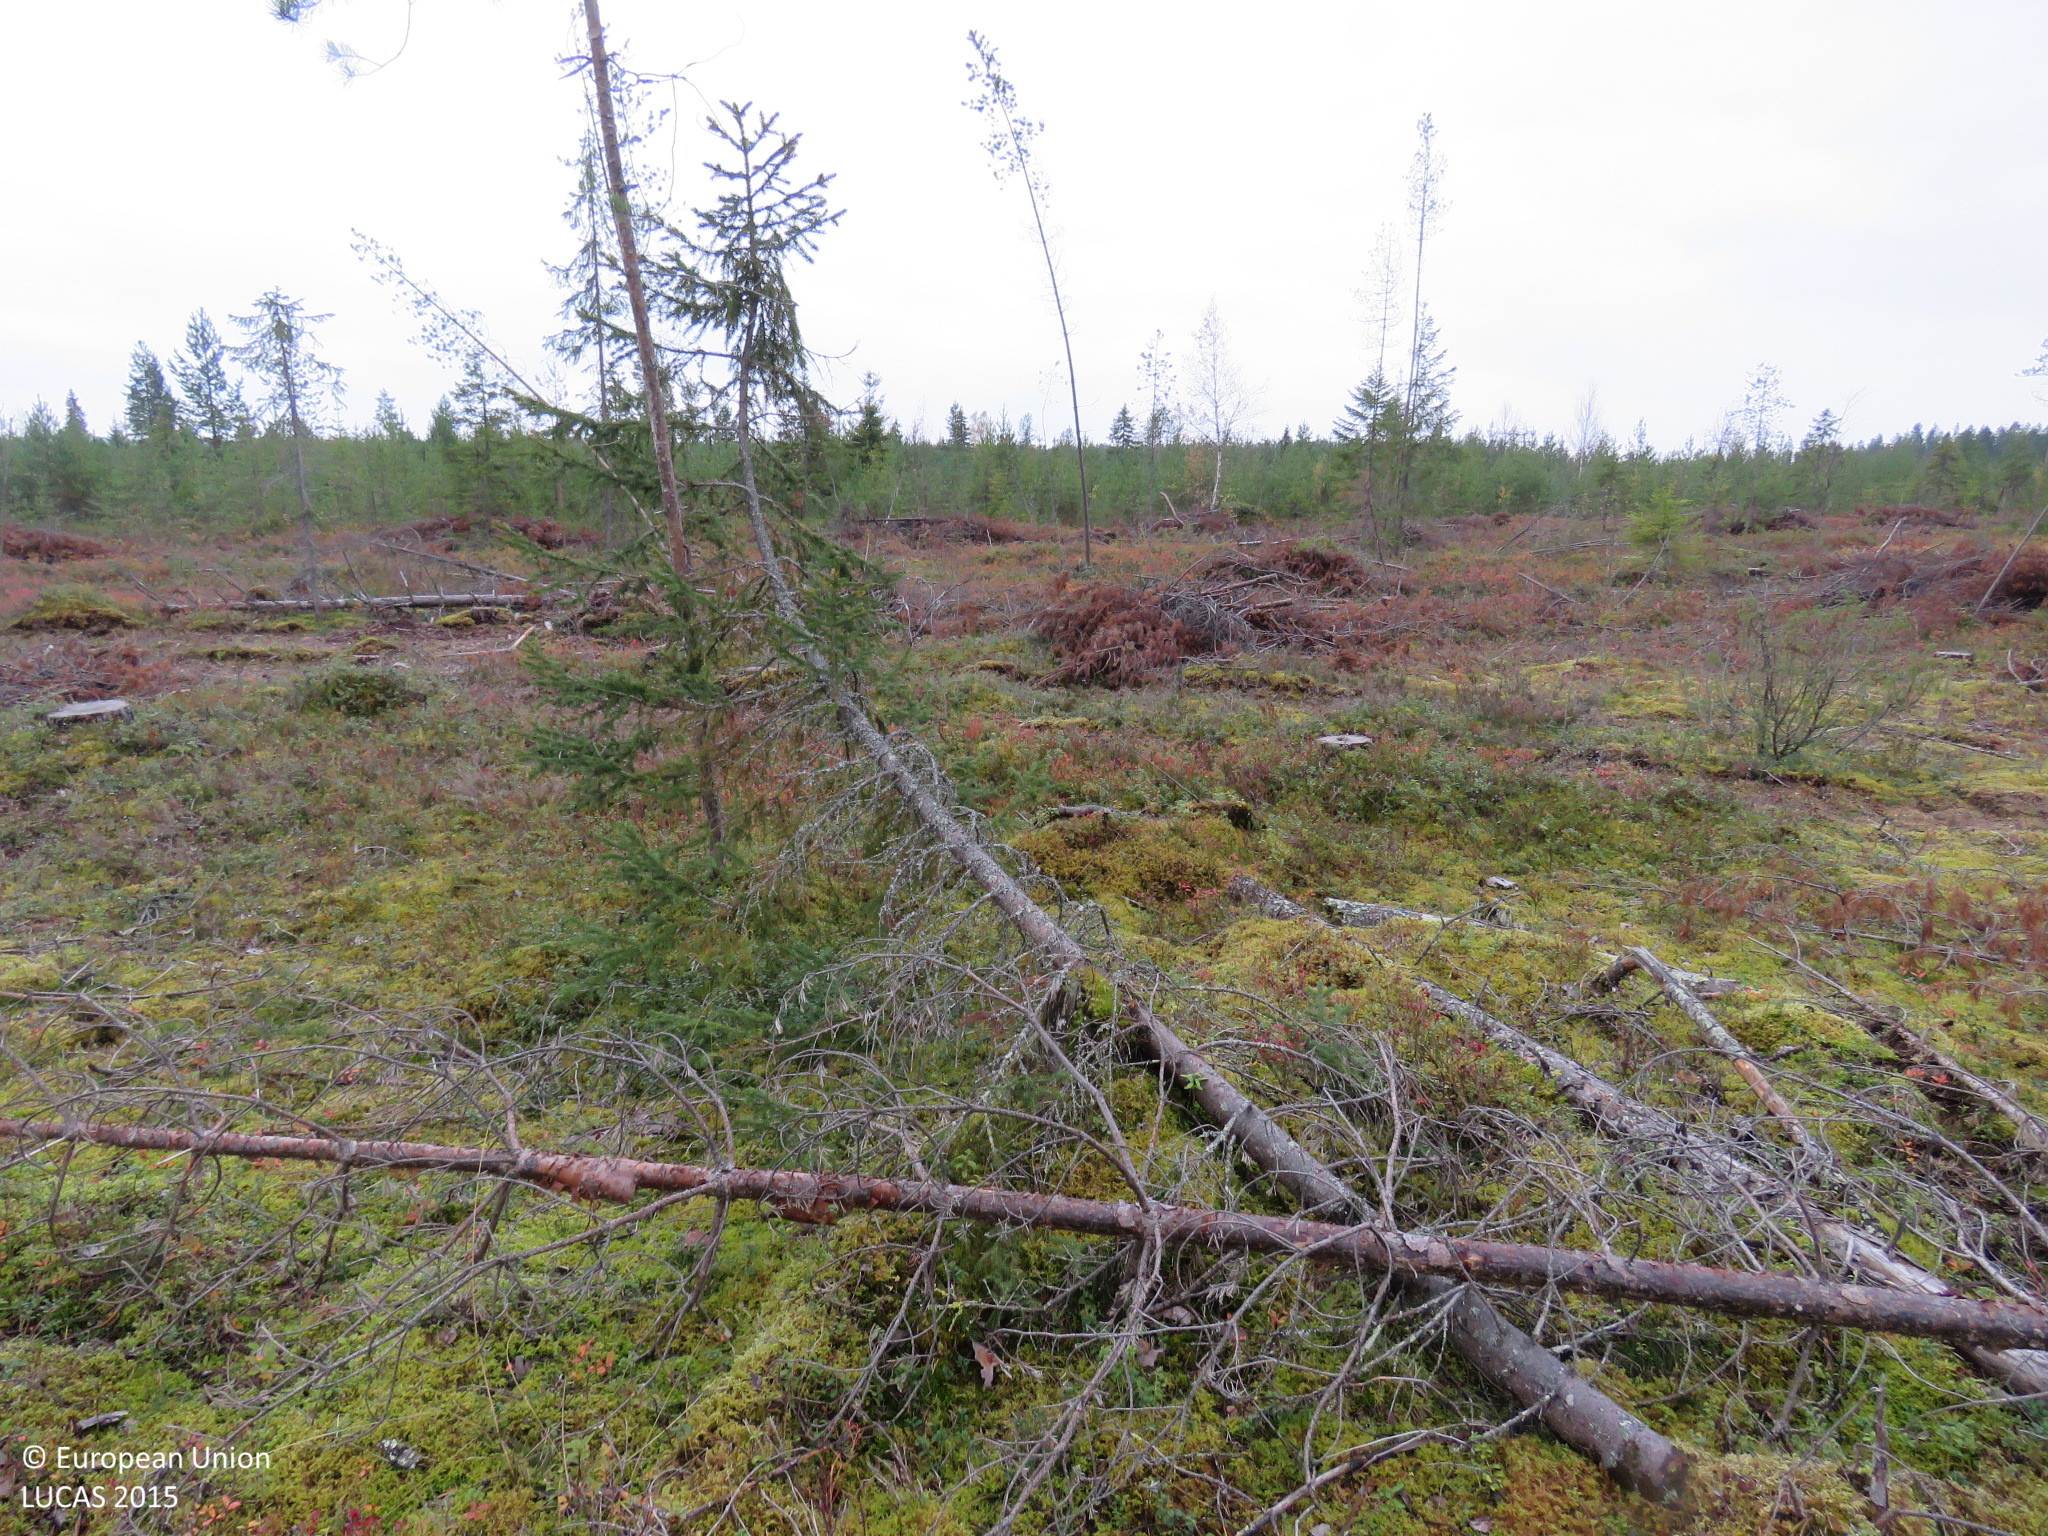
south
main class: Shrubland
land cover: Shrubland with sparse tree cover
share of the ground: 50 - 75 %
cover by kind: shrubs 55 %, lichens and mosses 30 %, coniferous forest trees 5 %, unconsolidated bare surface 5 %
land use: Forestry
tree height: < 5 m
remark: Clear cut
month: September
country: FI
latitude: 65.2923
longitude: 26.6389
